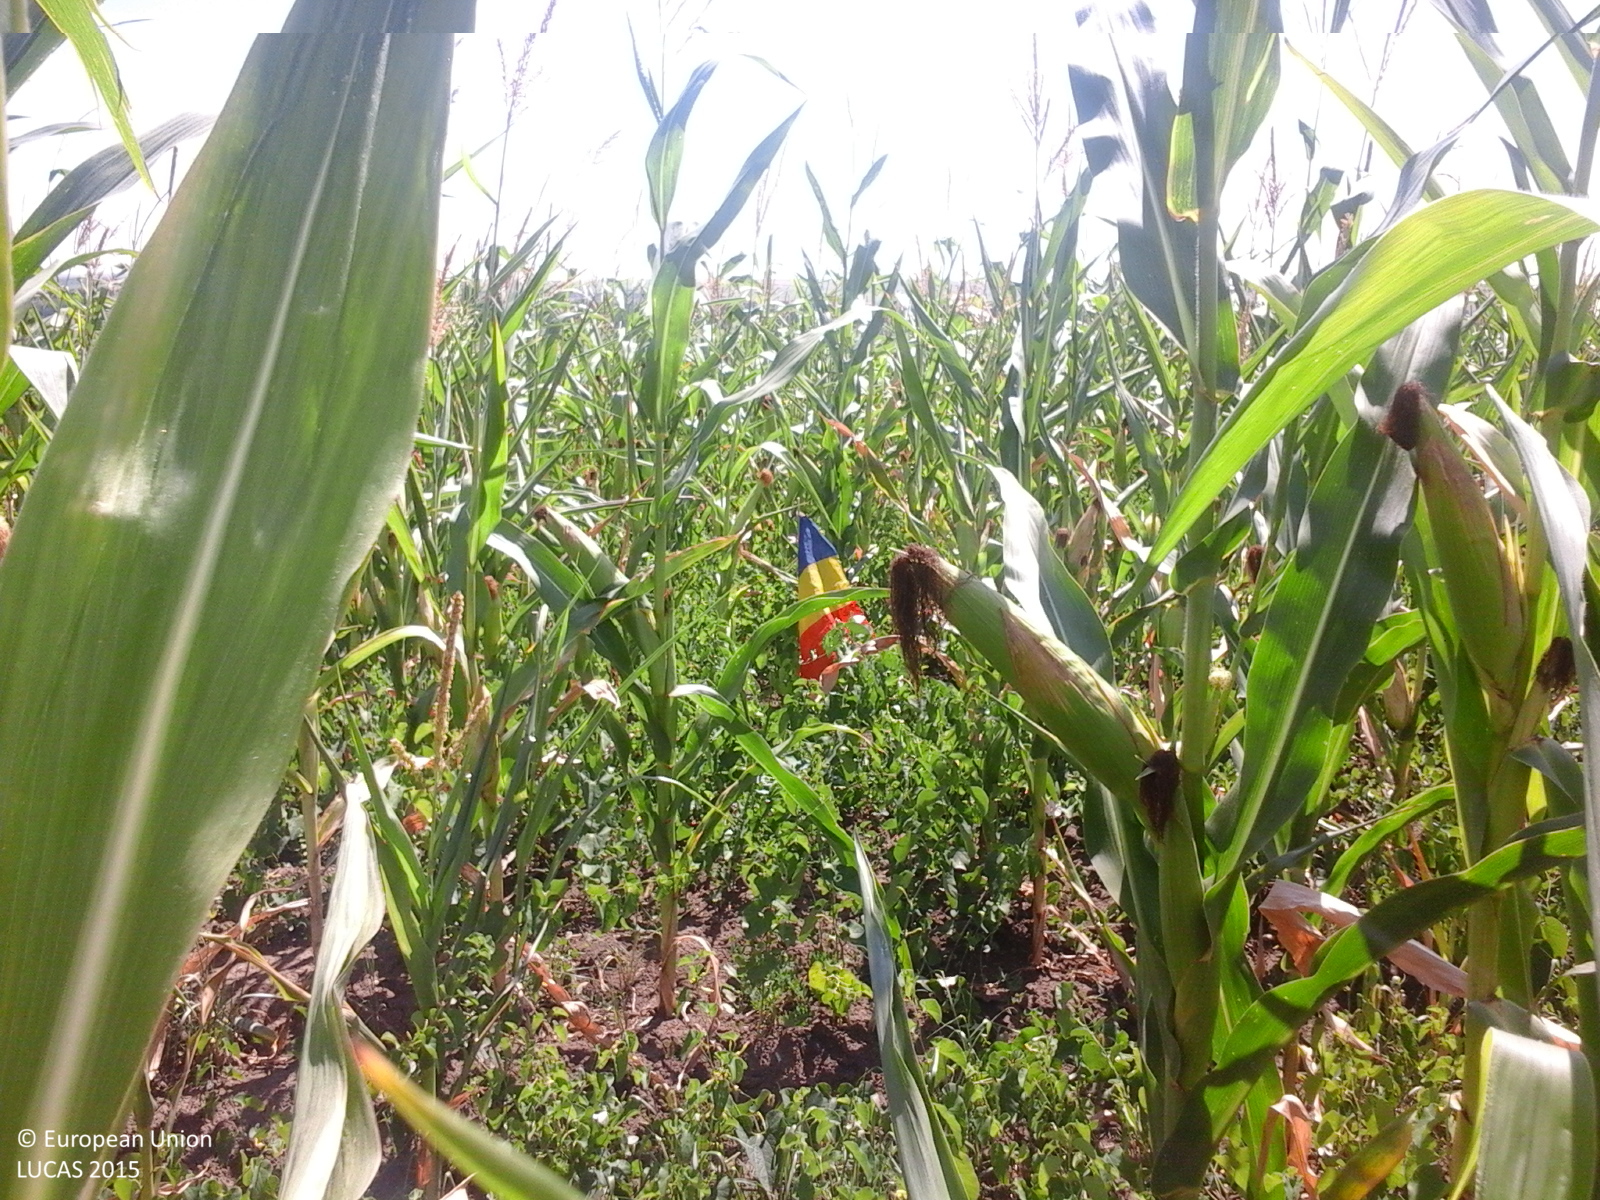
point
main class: Cropland
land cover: Maize
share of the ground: > 75 %
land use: Agriculture (excluding fallow land and kitchen gardens)
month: July
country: RO
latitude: 46.0771
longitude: 27.4720
